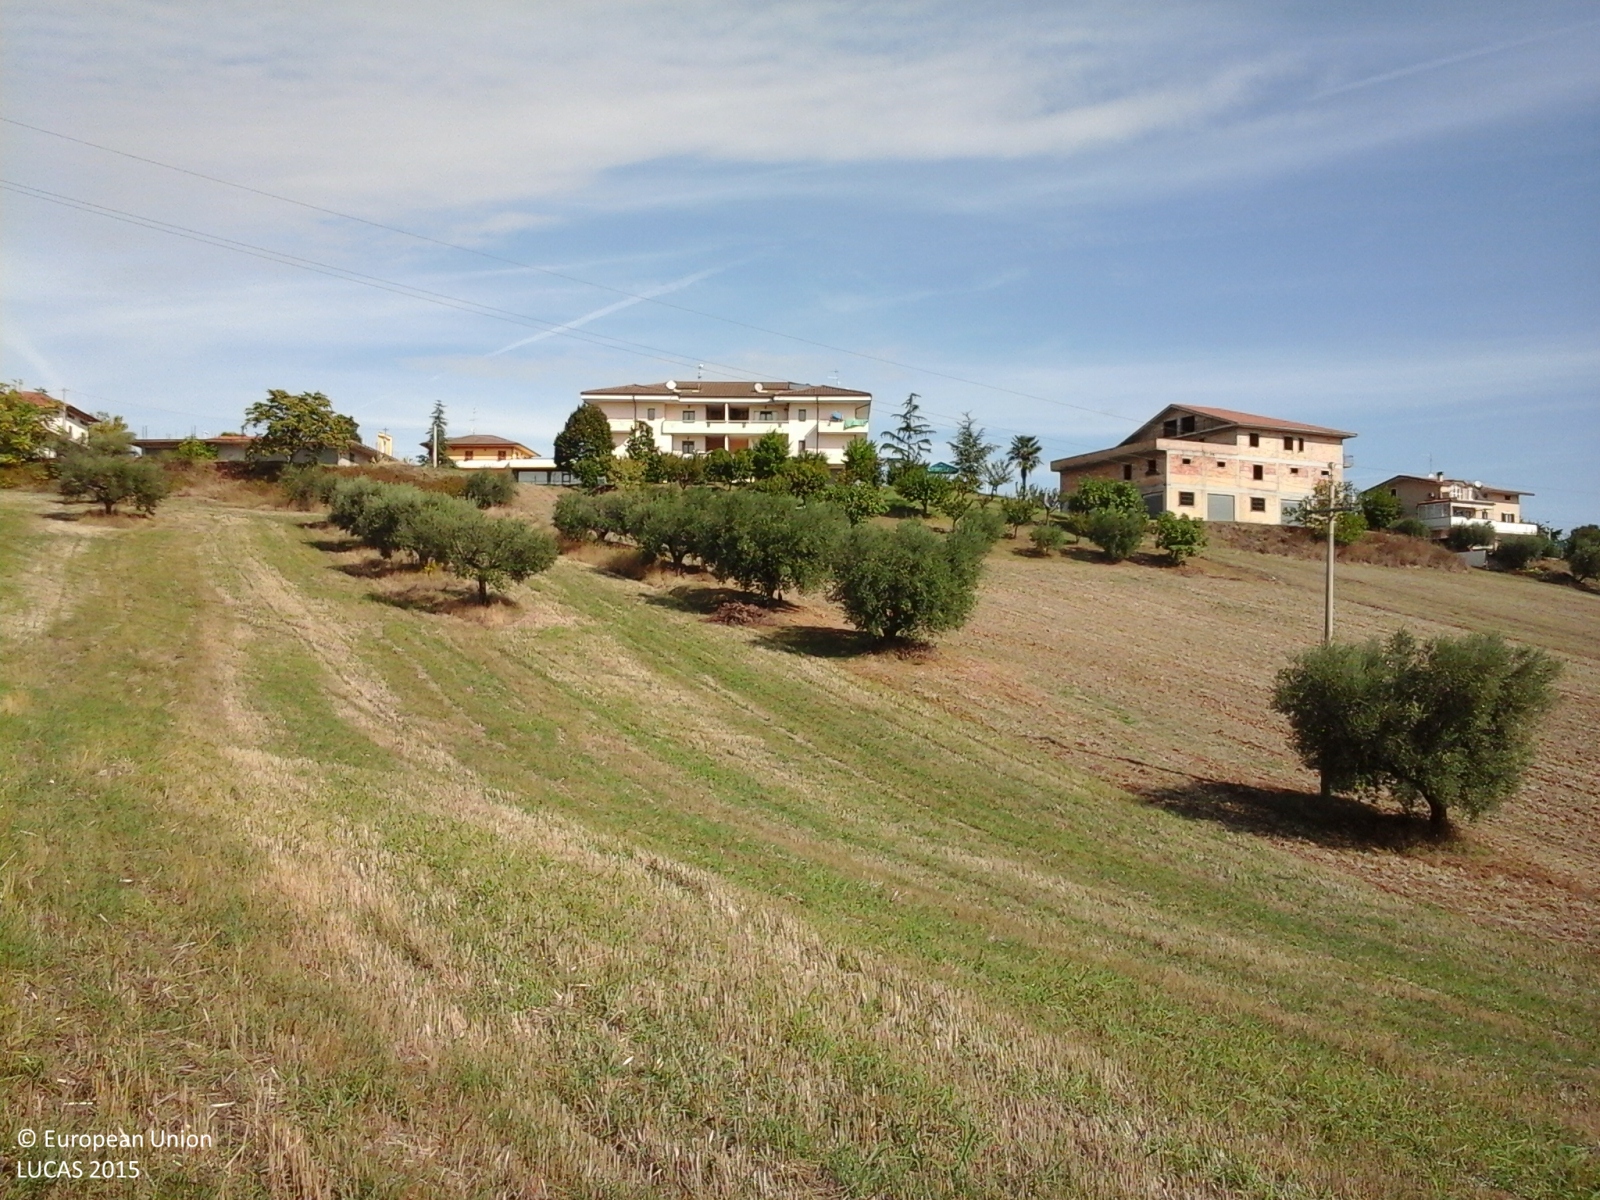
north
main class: Cropland
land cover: Common wheat
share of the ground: > 75 %
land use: Agriculture (excluding fallow land and kitchen gardens)
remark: Harvested field
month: September
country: IT
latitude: 42.8522
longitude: 13.8442
